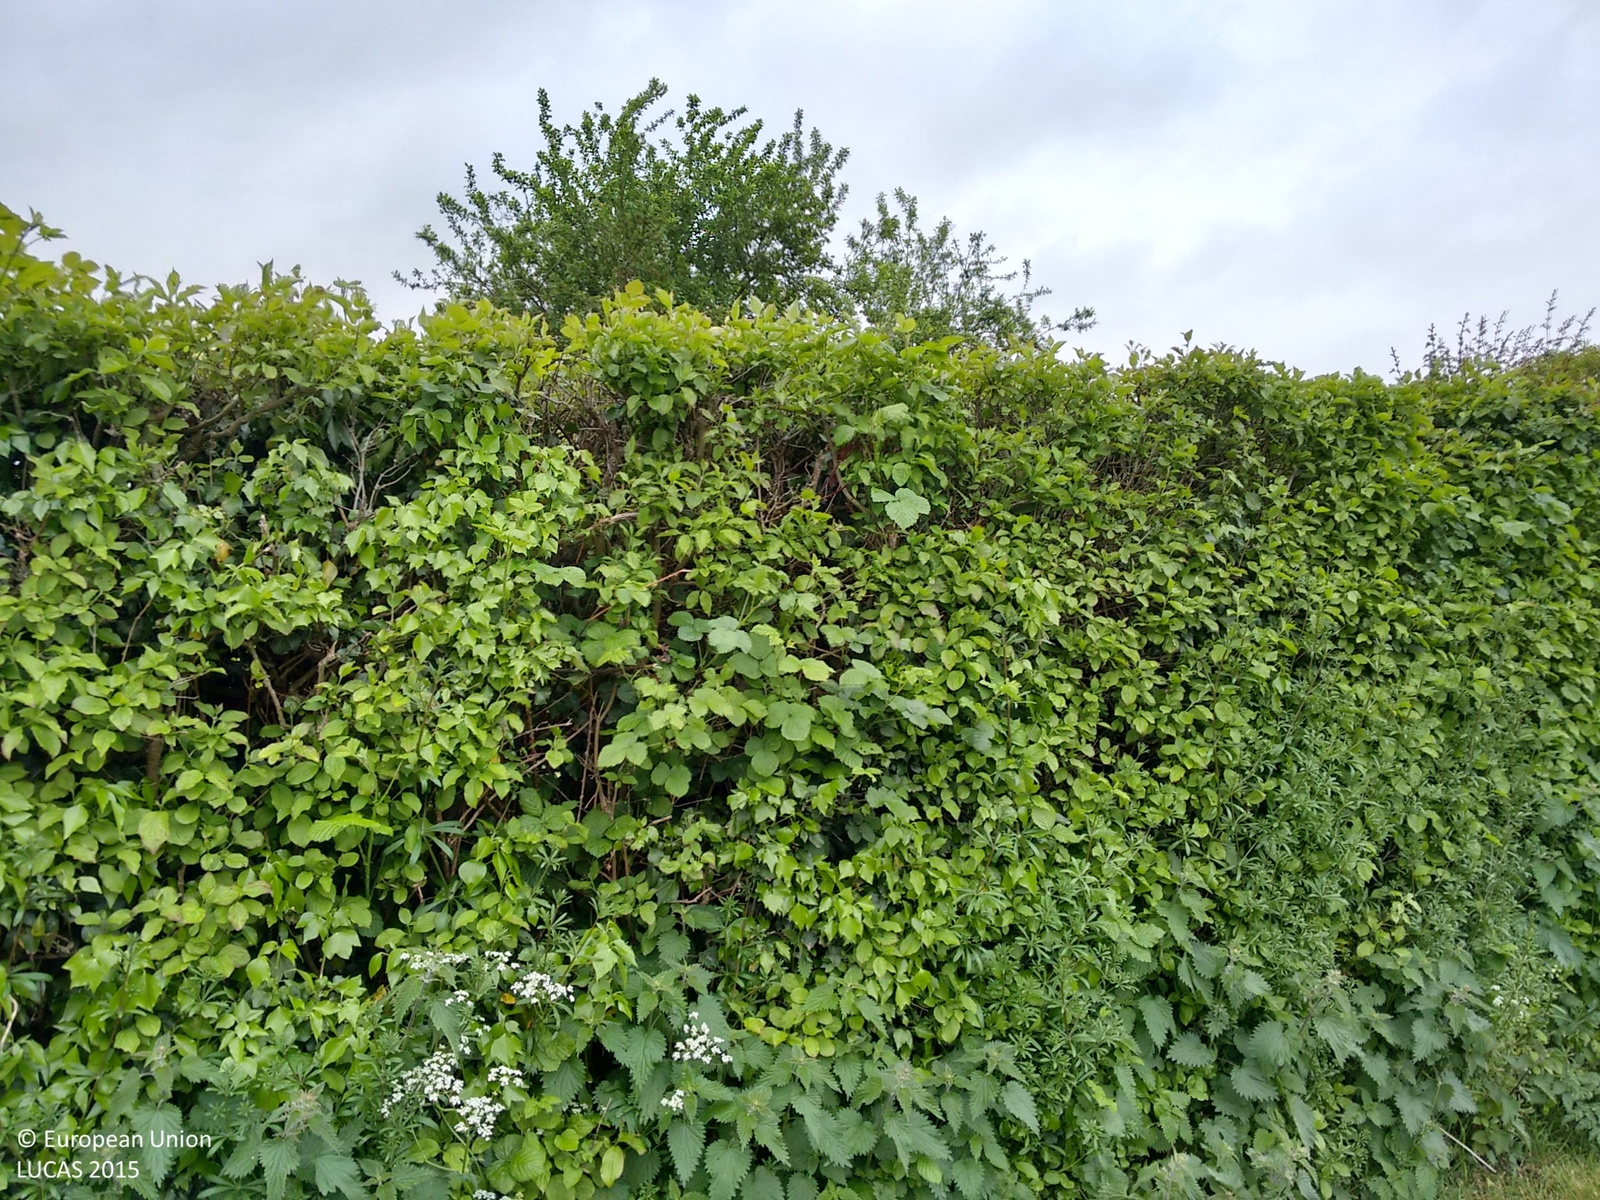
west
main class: Grassland
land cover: Grassland without tree/shrub cover
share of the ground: > 75 %
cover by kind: herbaceous plants 100 %
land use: Agriculture (excluding fallow land and kitchen gardens)
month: May
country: GB
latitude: 51.7108
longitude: -0.5020
